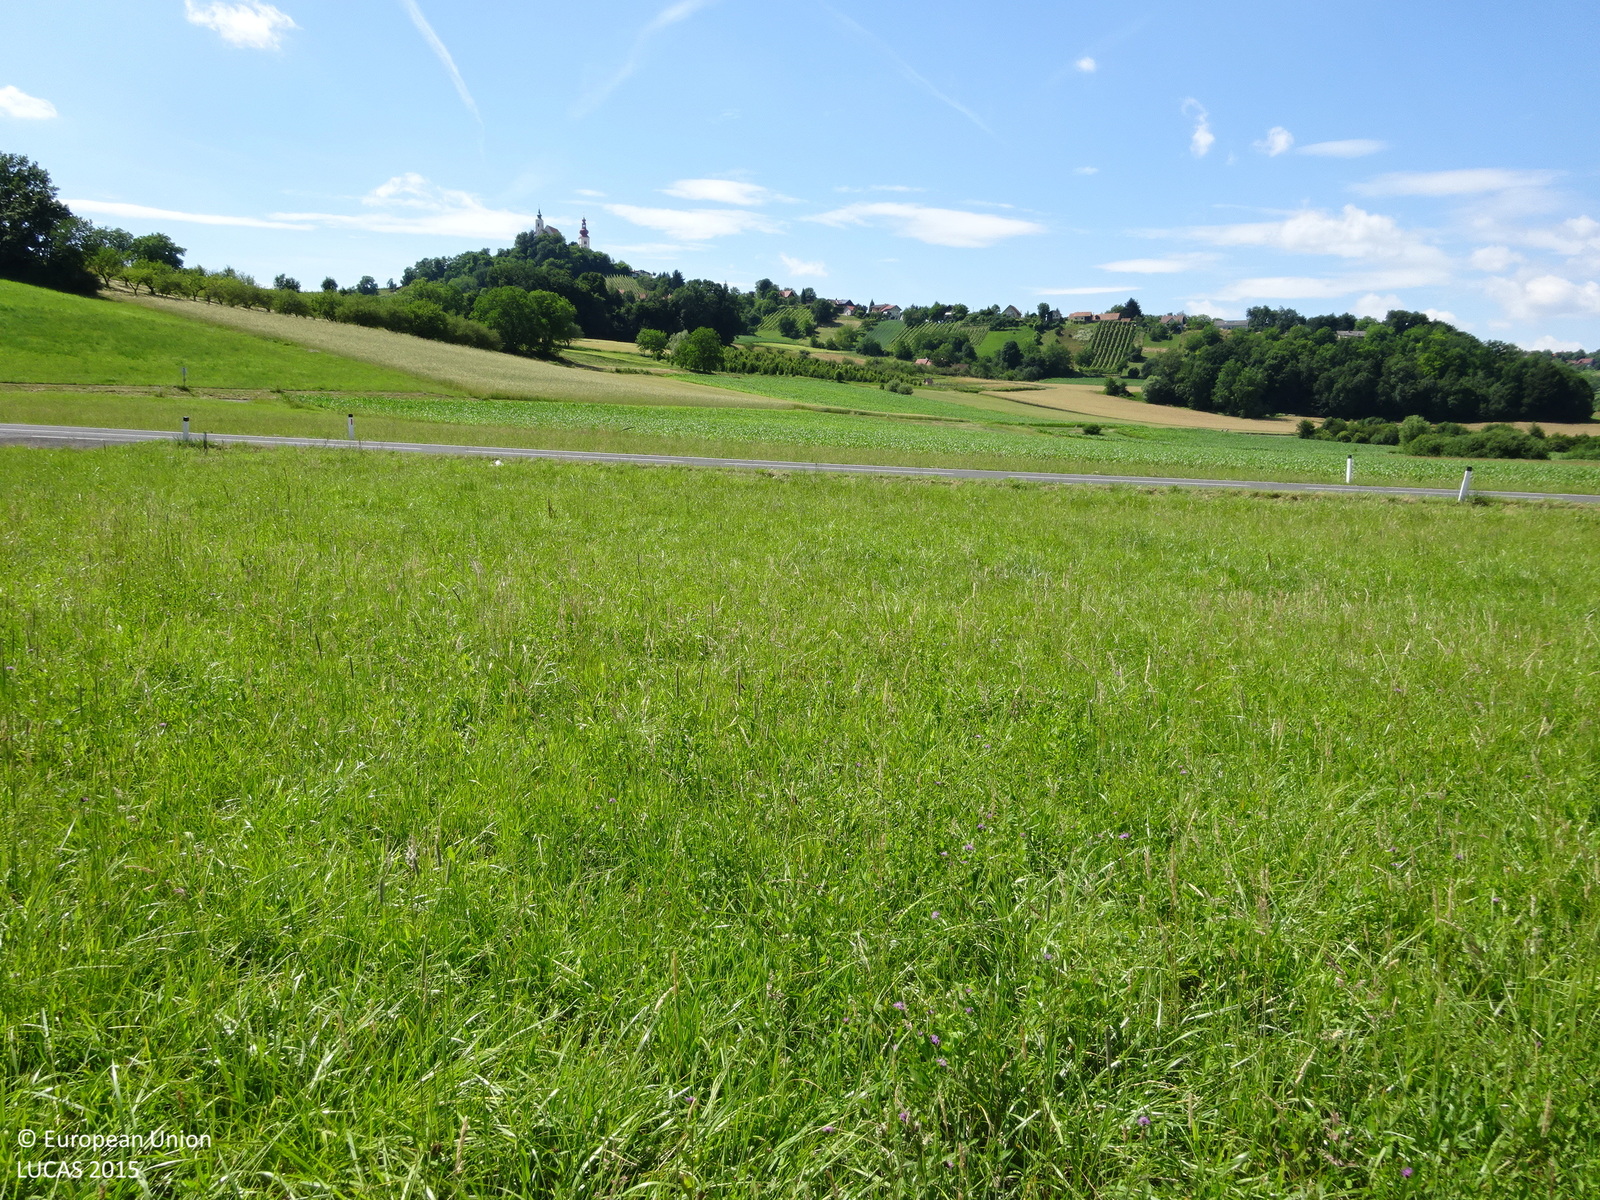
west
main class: Cropland
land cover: Maize
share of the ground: > 75 %
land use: Agriculture (excluding fallow land and kitchen gardens)
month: June
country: AT
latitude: 46.8031
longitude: 15.8836
